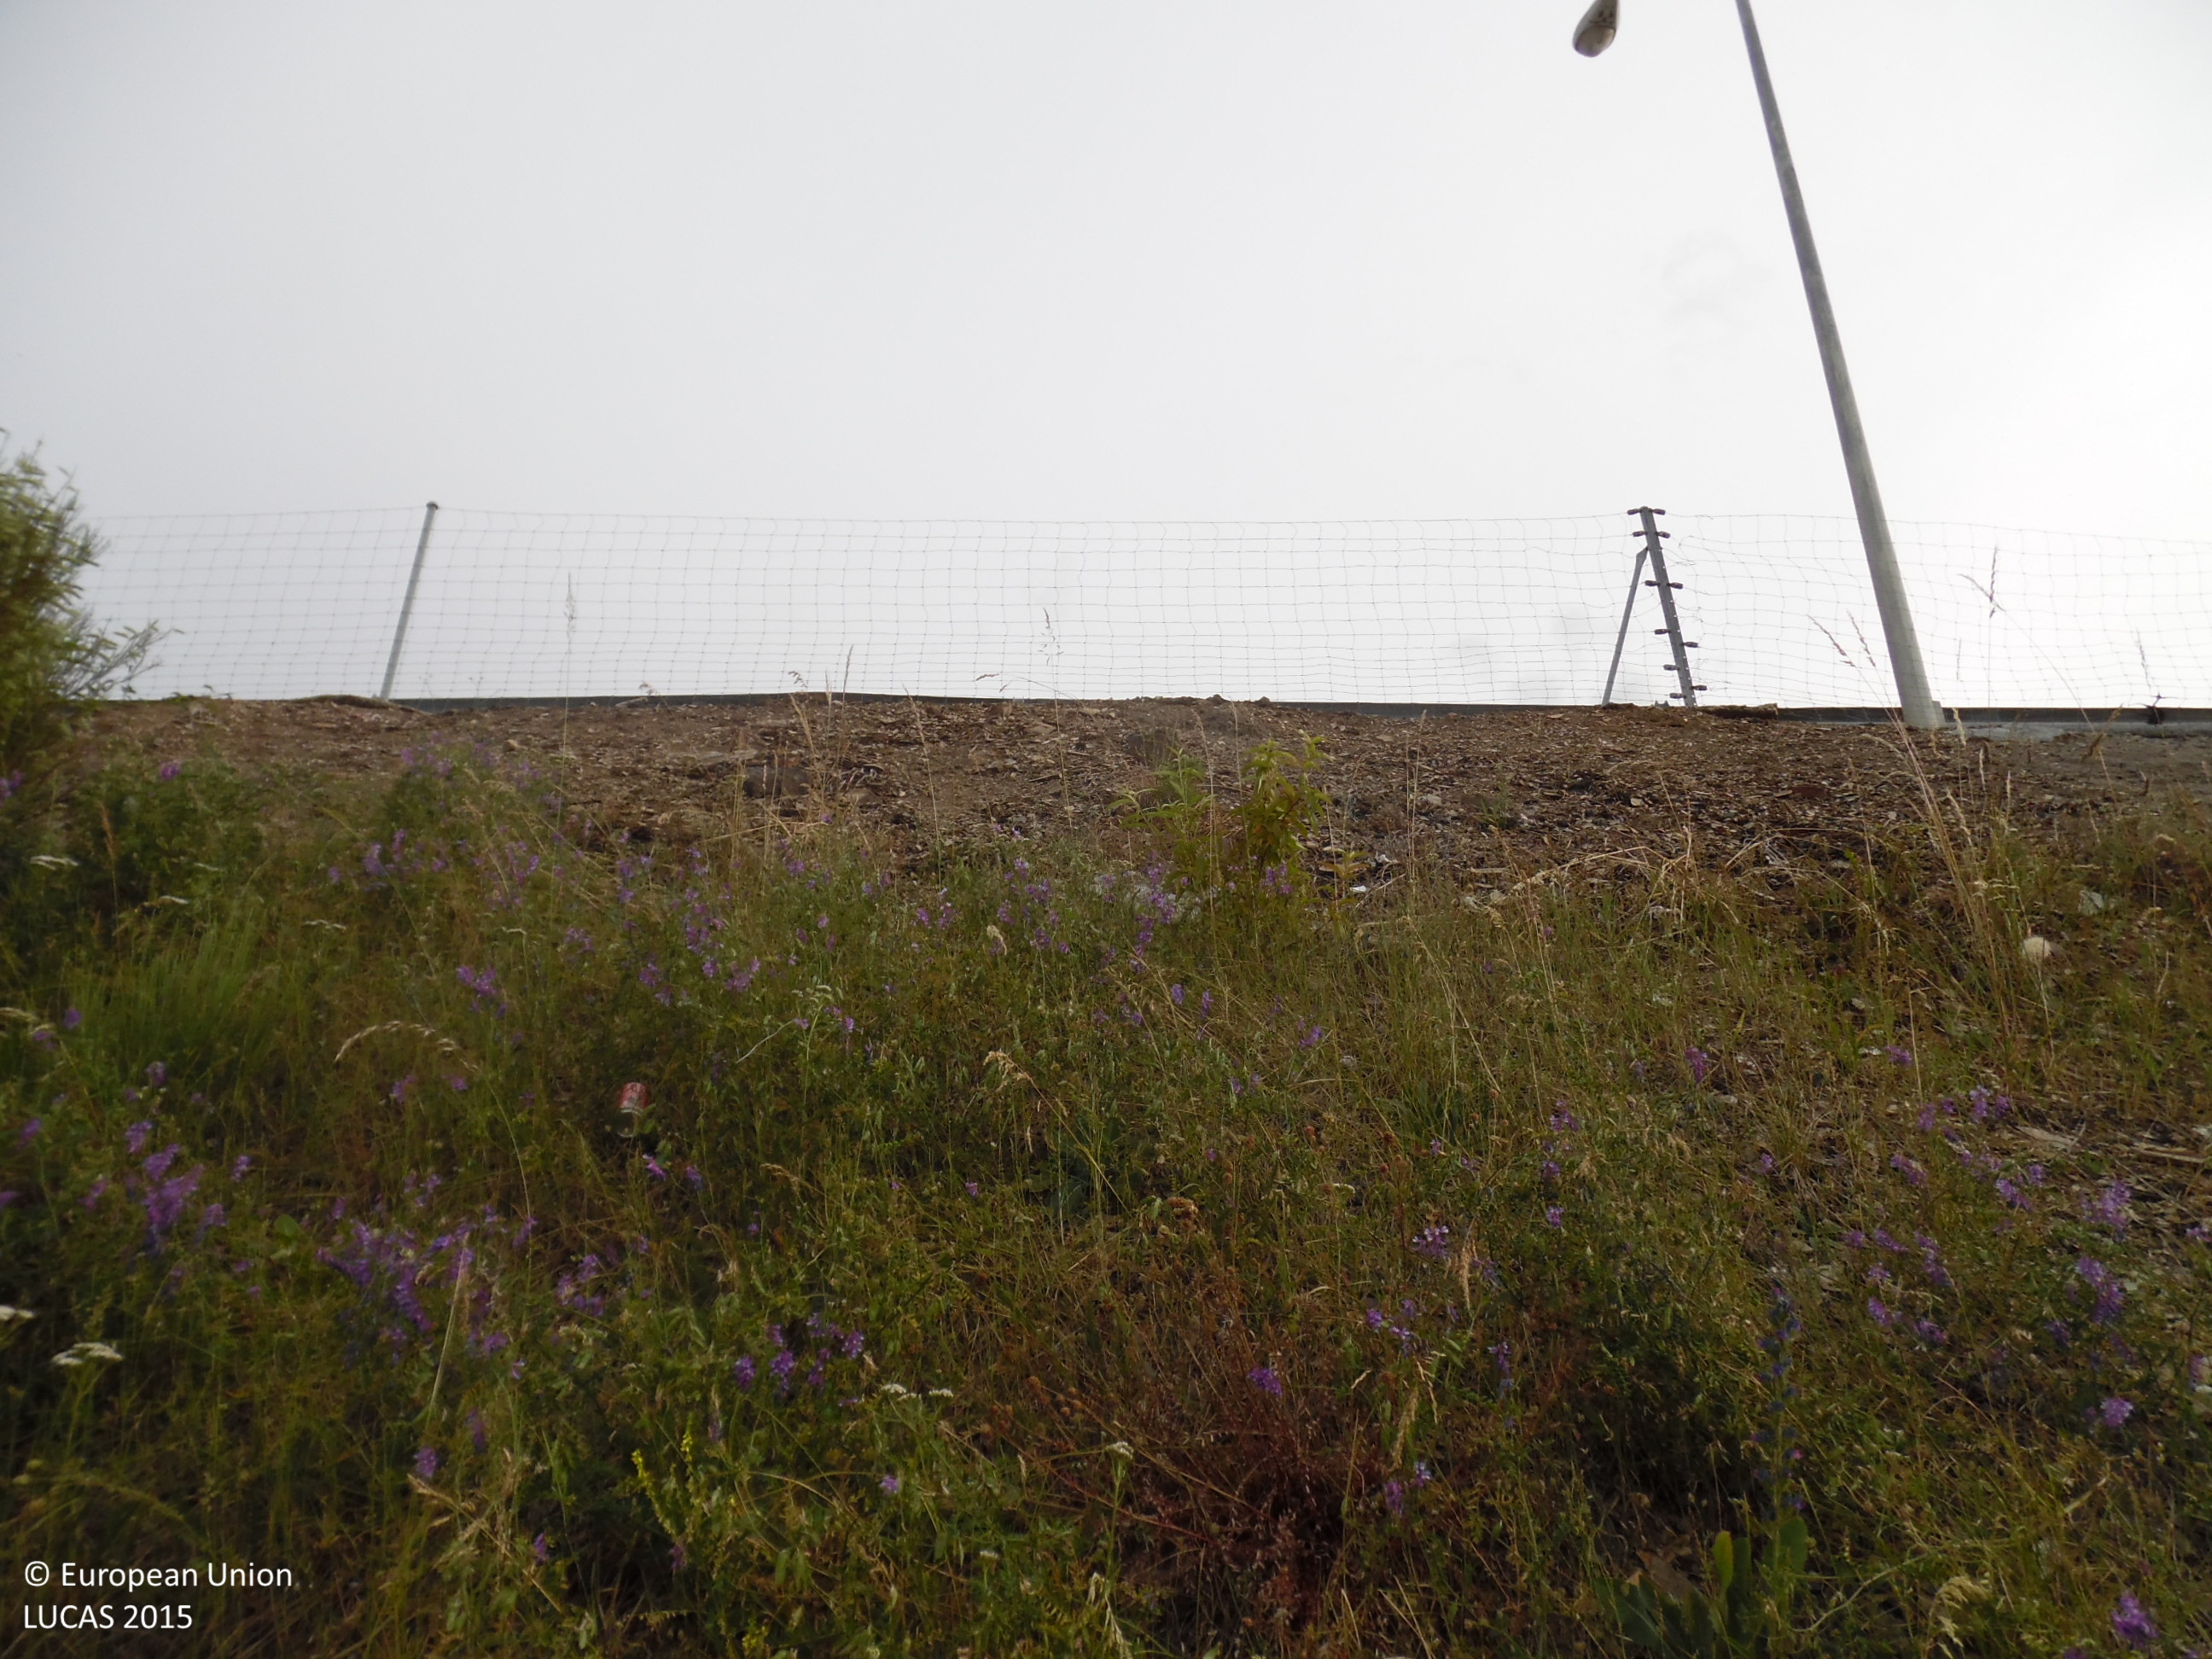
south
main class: Grassland
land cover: Grassland with sparse tree/shrub cover
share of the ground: 10 - 25 %
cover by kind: unconsolidated bare surface 70 %, herbaceous plants 25 %, broadleaved forest trees 5 %
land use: Road transport
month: June
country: ES
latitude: 42.7841
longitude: -5.7875
